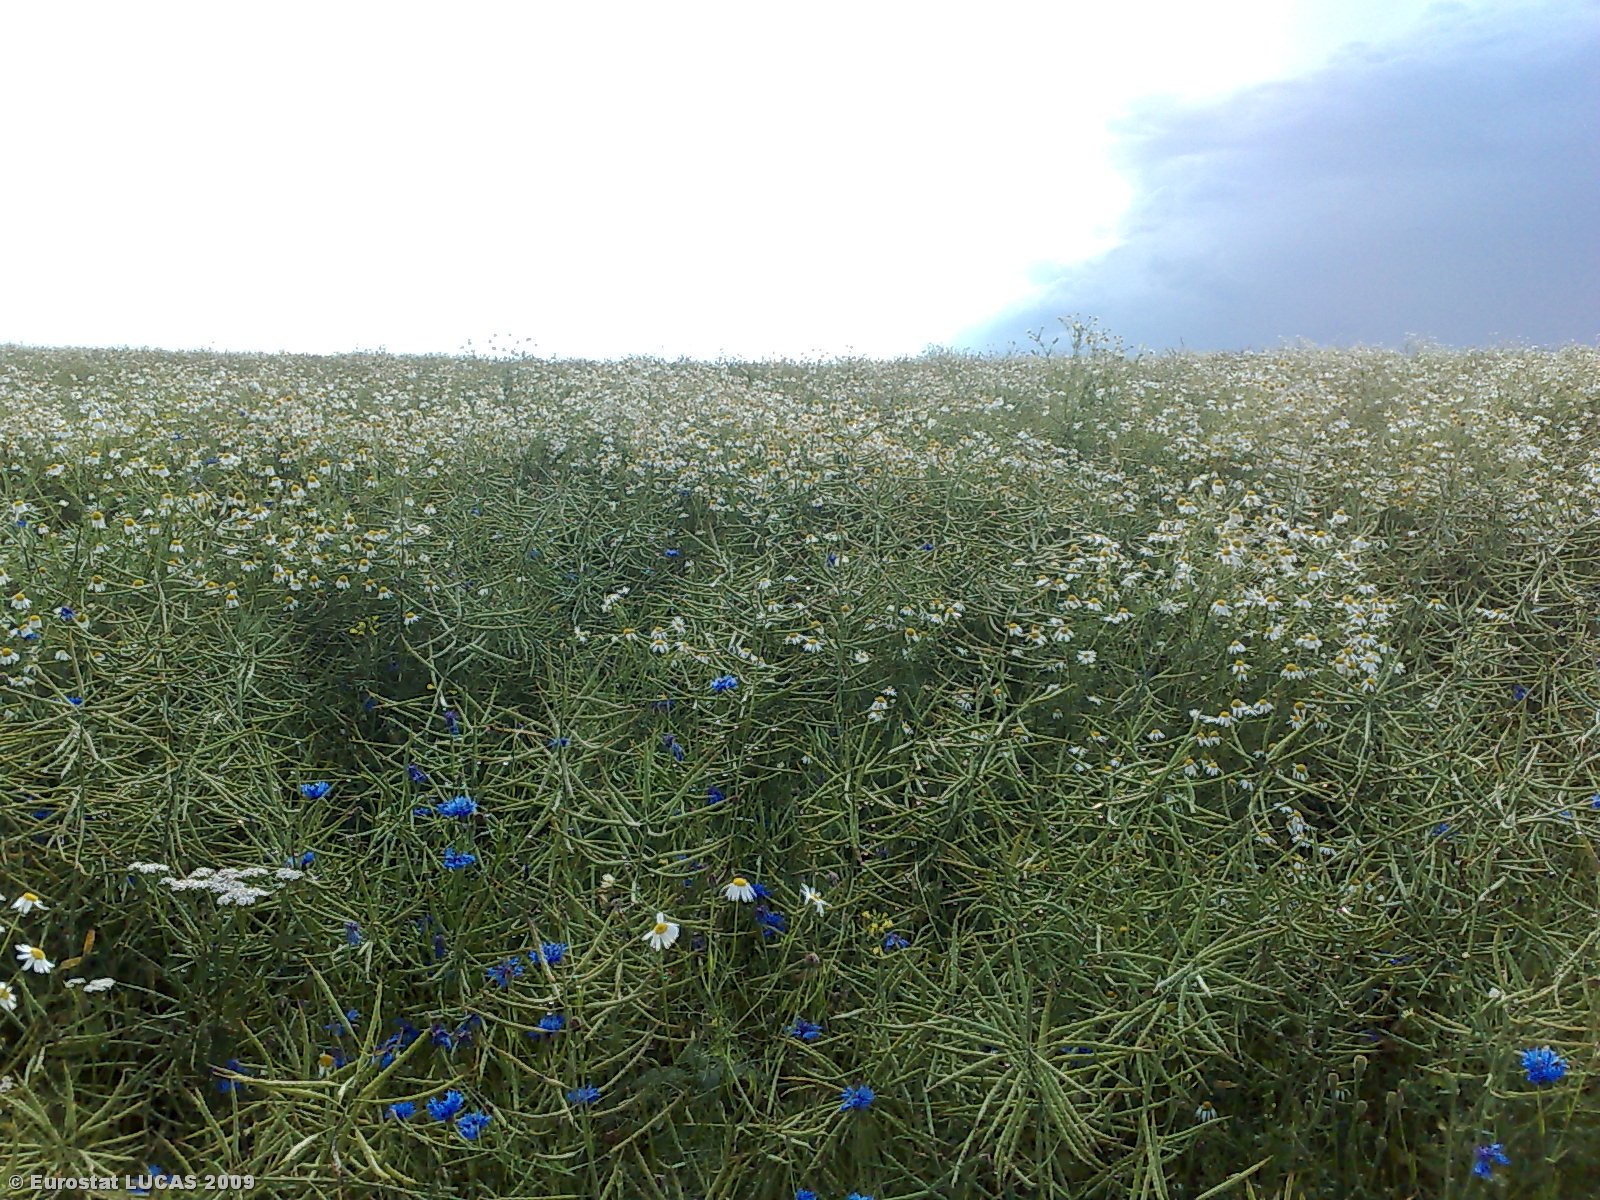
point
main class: Cropland
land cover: Rape and turnip rape
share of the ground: > 75 %
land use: Agriculture (excluding fallow land and kitchen gardens)
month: July
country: LT
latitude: 55.6500
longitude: 22.8267
